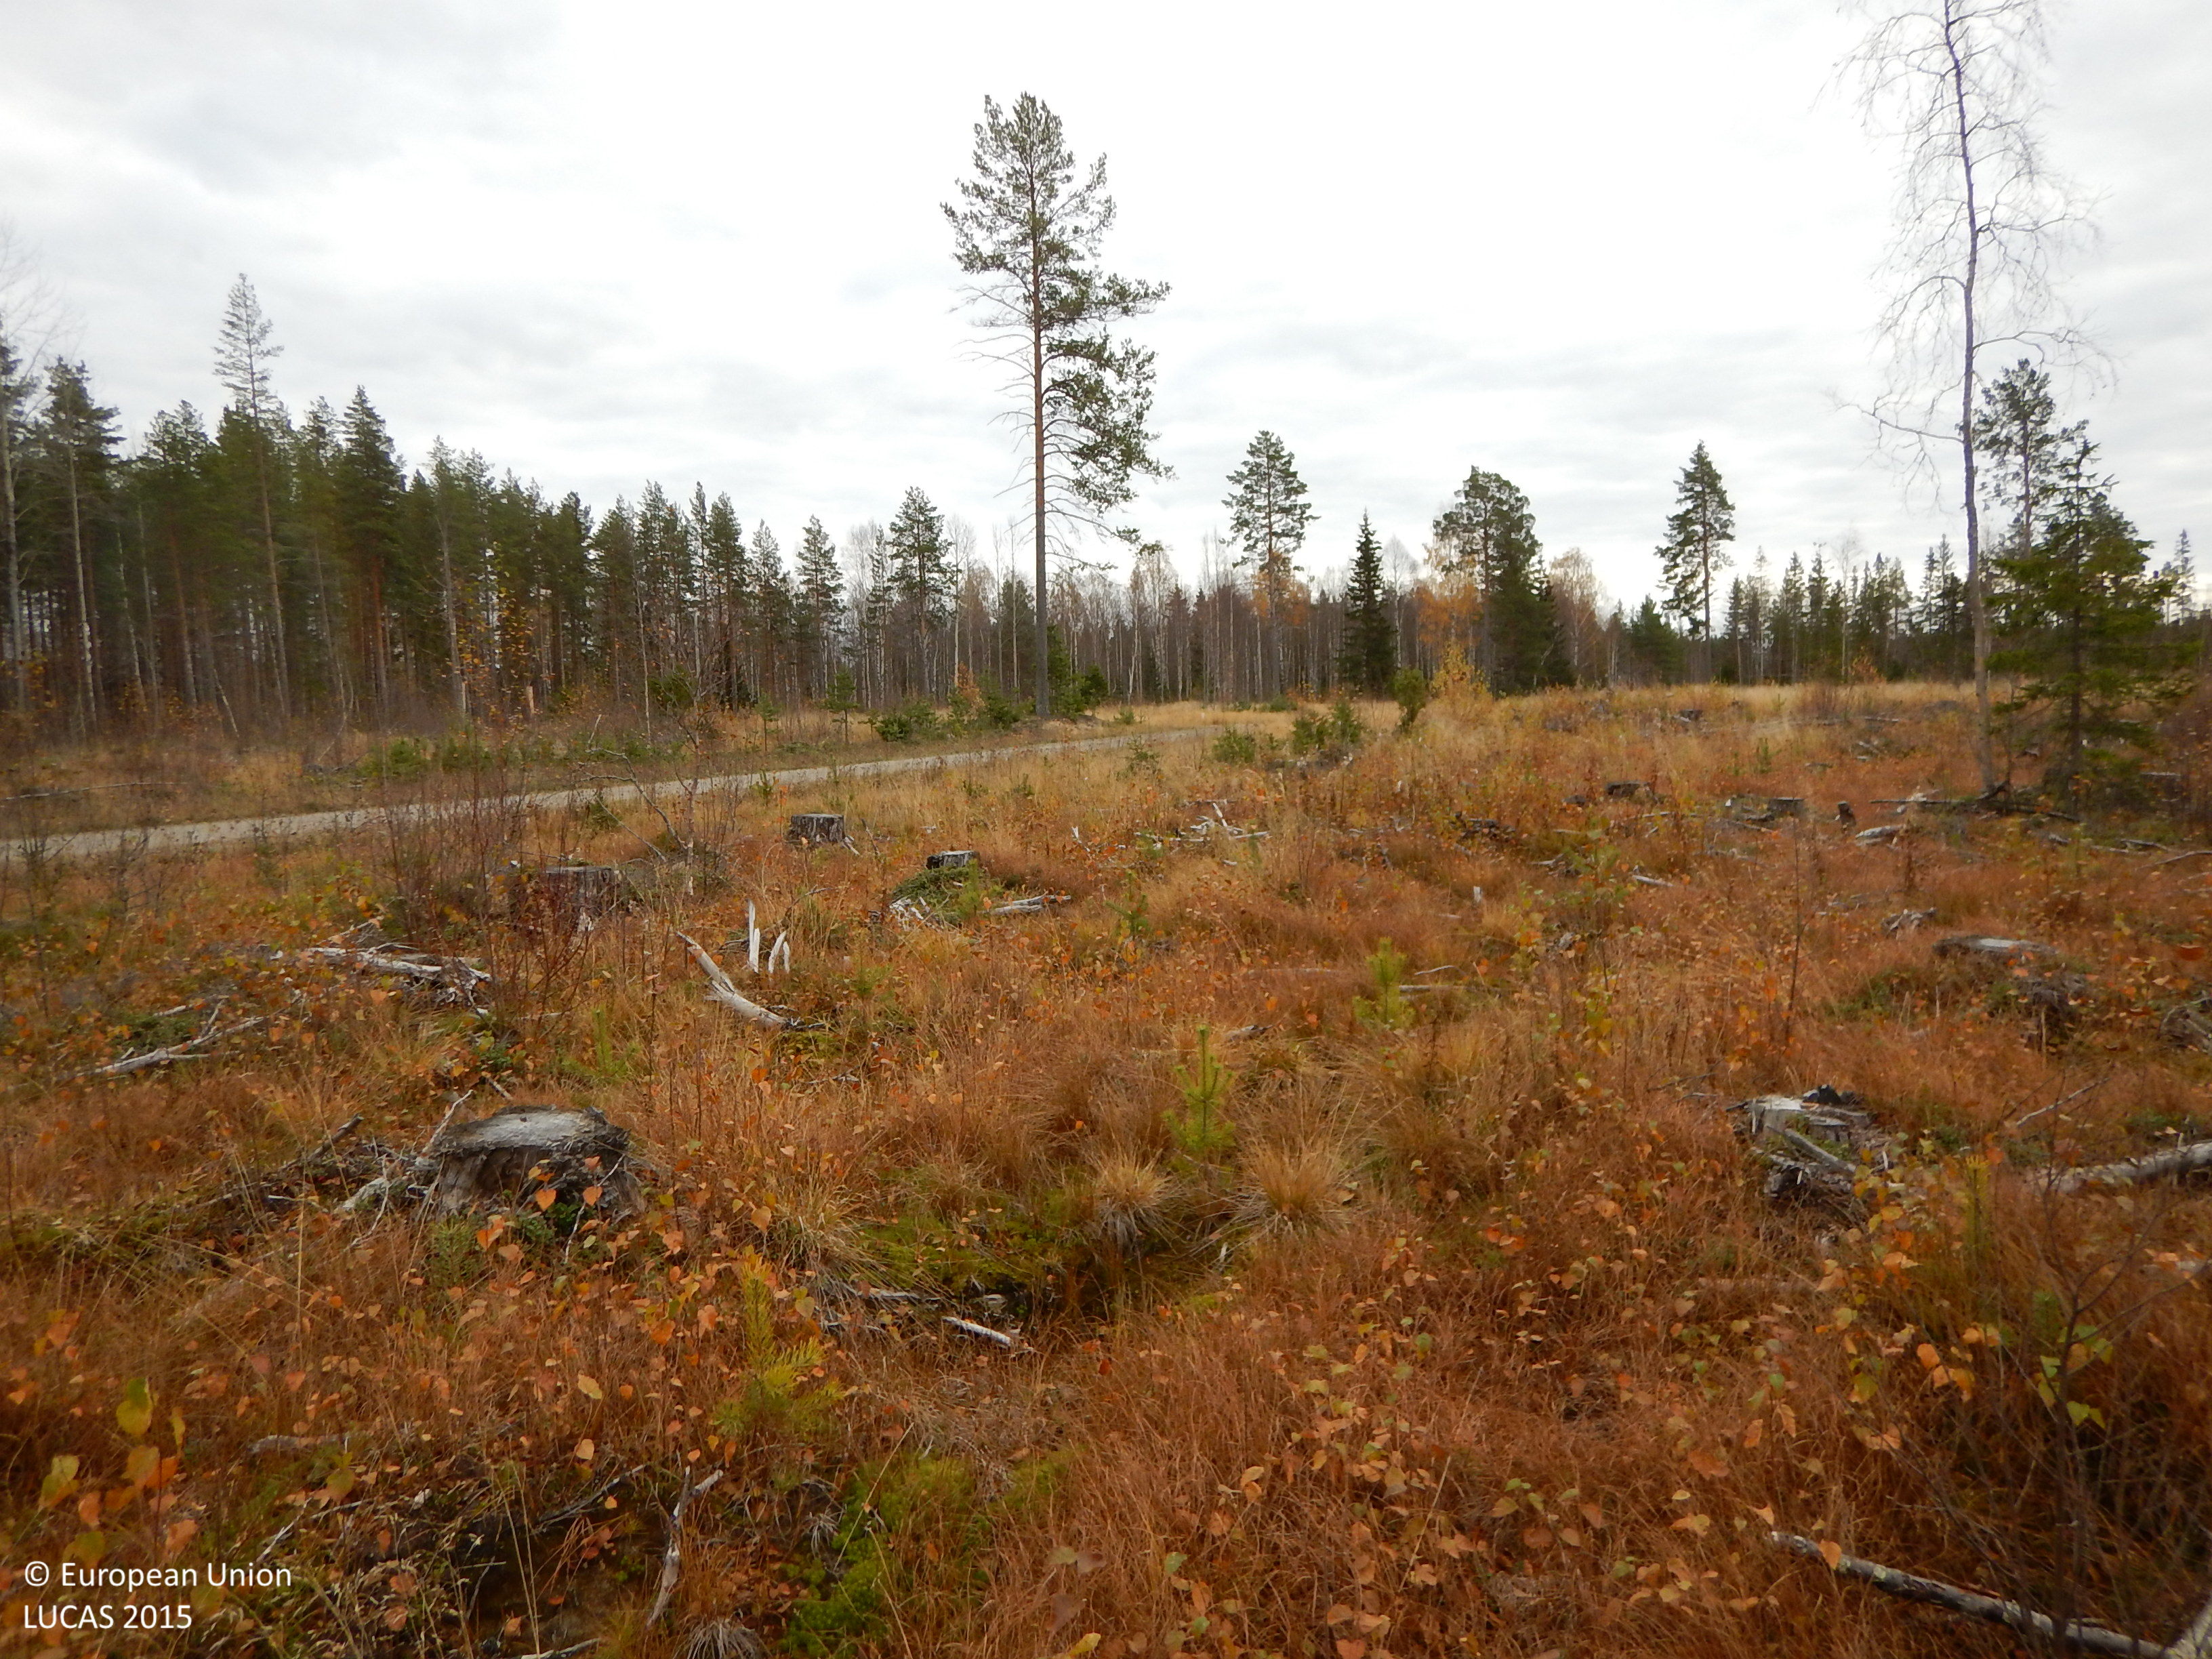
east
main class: Woodland
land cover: Other mixed woodland
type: boreal forest
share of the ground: 25 - 50 %
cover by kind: broadleaved forest trees 30 %, shrubs 25 %, herbaceous plants 20 %, lichens and mosses 15 %, coniferous forest trees 10 %
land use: Forestry
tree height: < 5 m
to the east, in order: Other mixed woodland; Grass margins; Ditches and canals; Paved roads, cycling and walking lanes; Ditches and canals; Grass margins; Shrubland with sparse tree cover; Tracks; Shrubland with sparse tree cover; Pine dominated coniferous woodland; Tracks; Broadleaved woodland; Ditches and canals; Broadleaved woodland
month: October
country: SE
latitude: 64.9765
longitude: 21.1005
